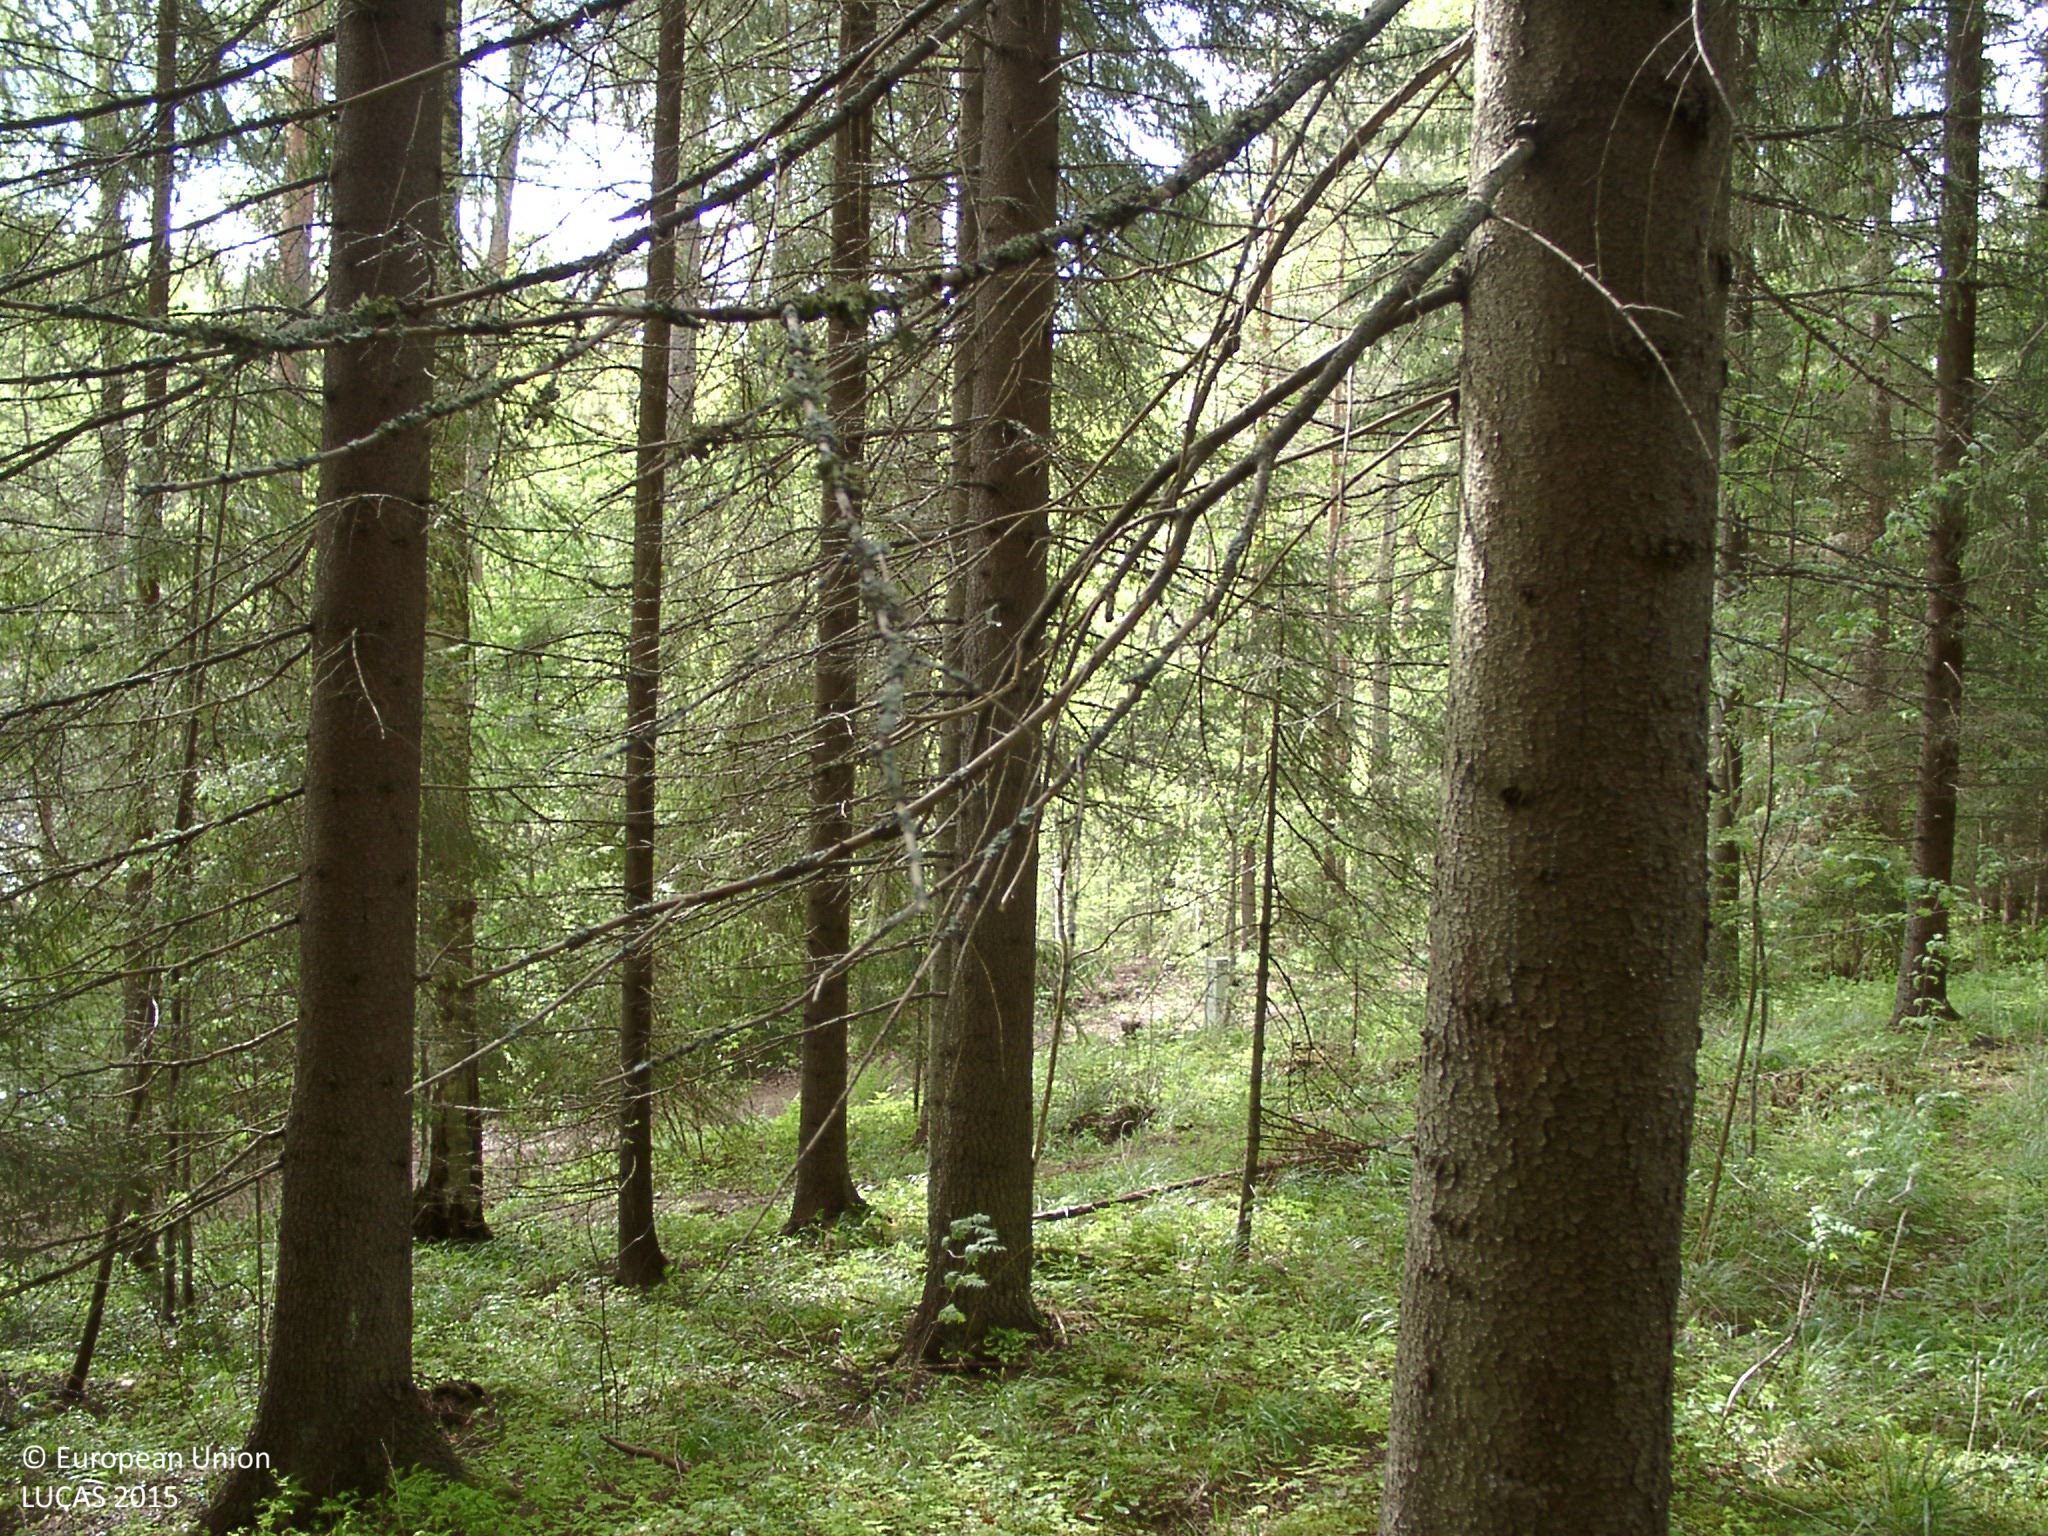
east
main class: Woodland
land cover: Spruce dominated coniferous woodland
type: boreal forest
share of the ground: > 75 %
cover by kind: coniferous forest trees 80 %, herbaceous plants 10 %, broadleaved forest trees 5 %, lichens and mosses 5 %
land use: Forestry
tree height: > 5 m
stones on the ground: < 10 %
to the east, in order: Spruce dominated coniferous woodland; Tracks; Spruce dominated mixed woodland; Spruce dominated coniferous woodland; Tracks; Ditches and canals; Grassland with sparse tree/shrub cover; Spruce dominated coniferous woodland
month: June
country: FI
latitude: 62.1677
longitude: 25.5329
